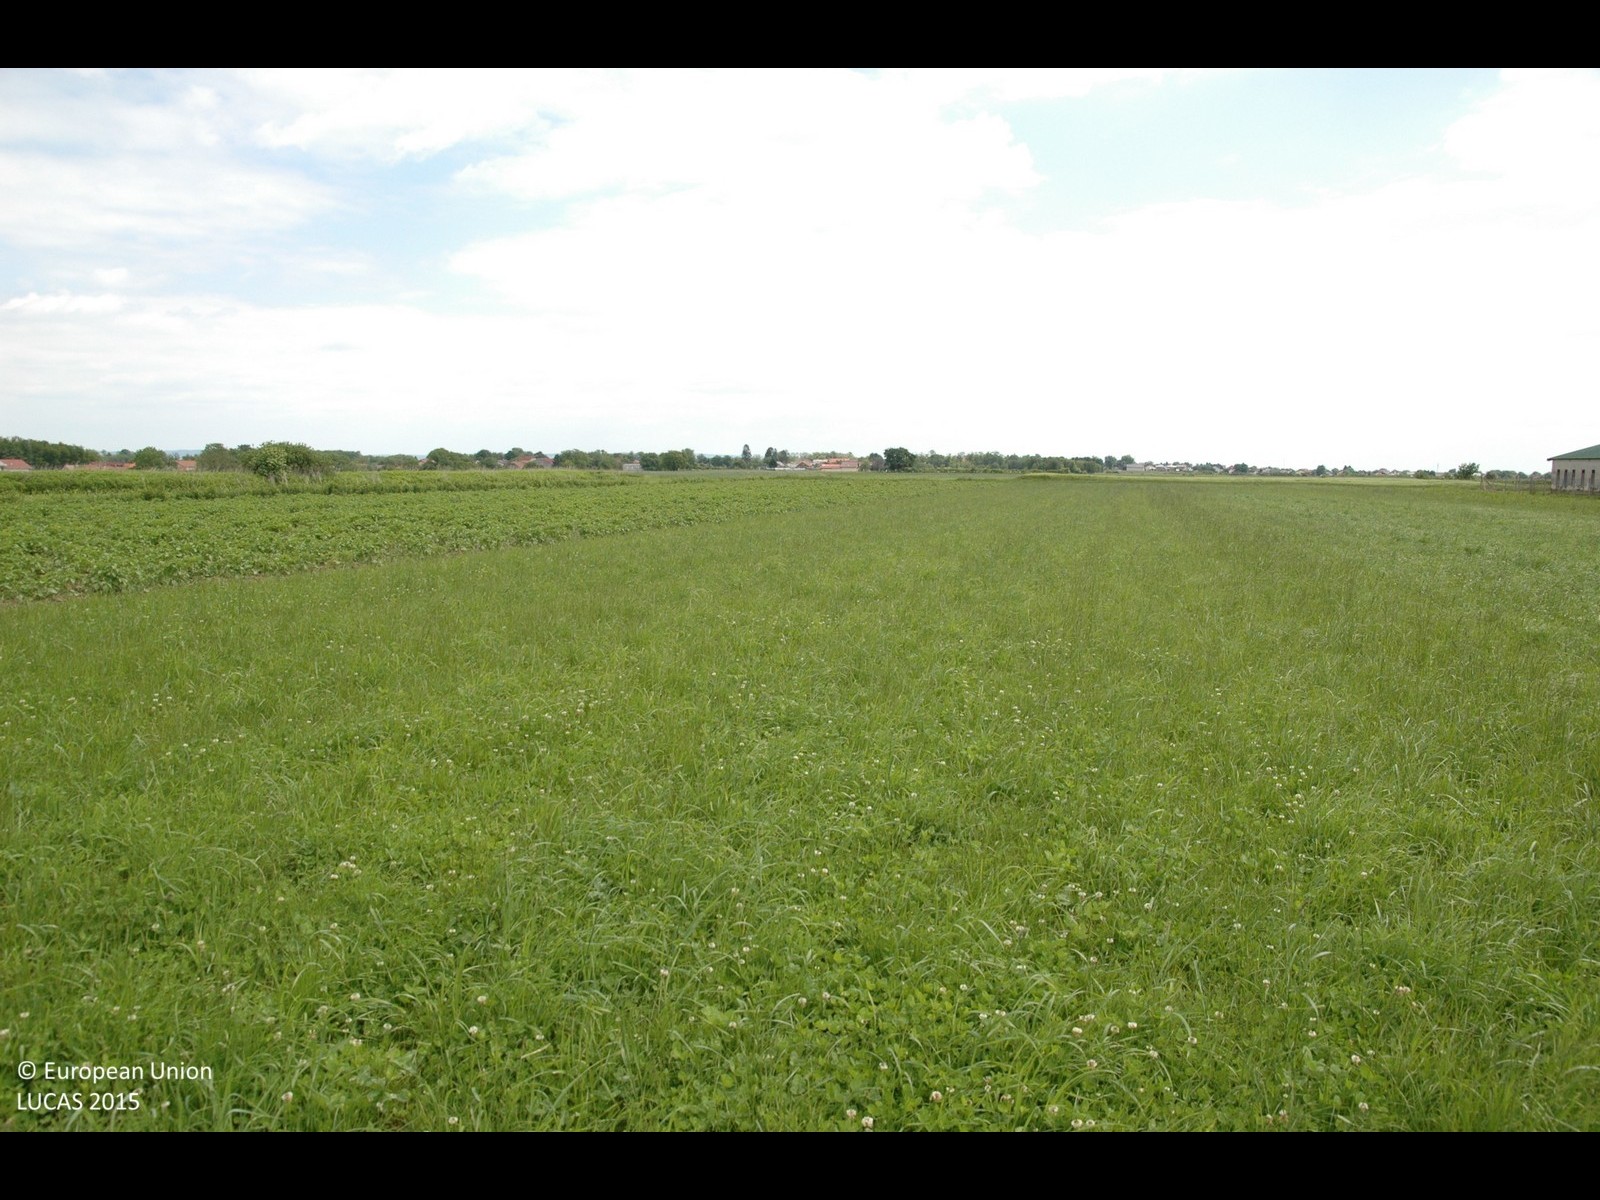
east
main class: Grassland
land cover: Grassland without tree/shrub cover
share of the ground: > 75 %
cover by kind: herbaceous plants 100 %
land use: Agriculture (excluding fallow land and kitchen gardens)
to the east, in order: Grassland without tree/shrub cover; Potatoes; Tracks; Maize; Potatoes
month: May
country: HR
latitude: 46.4280
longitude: 16.4422
